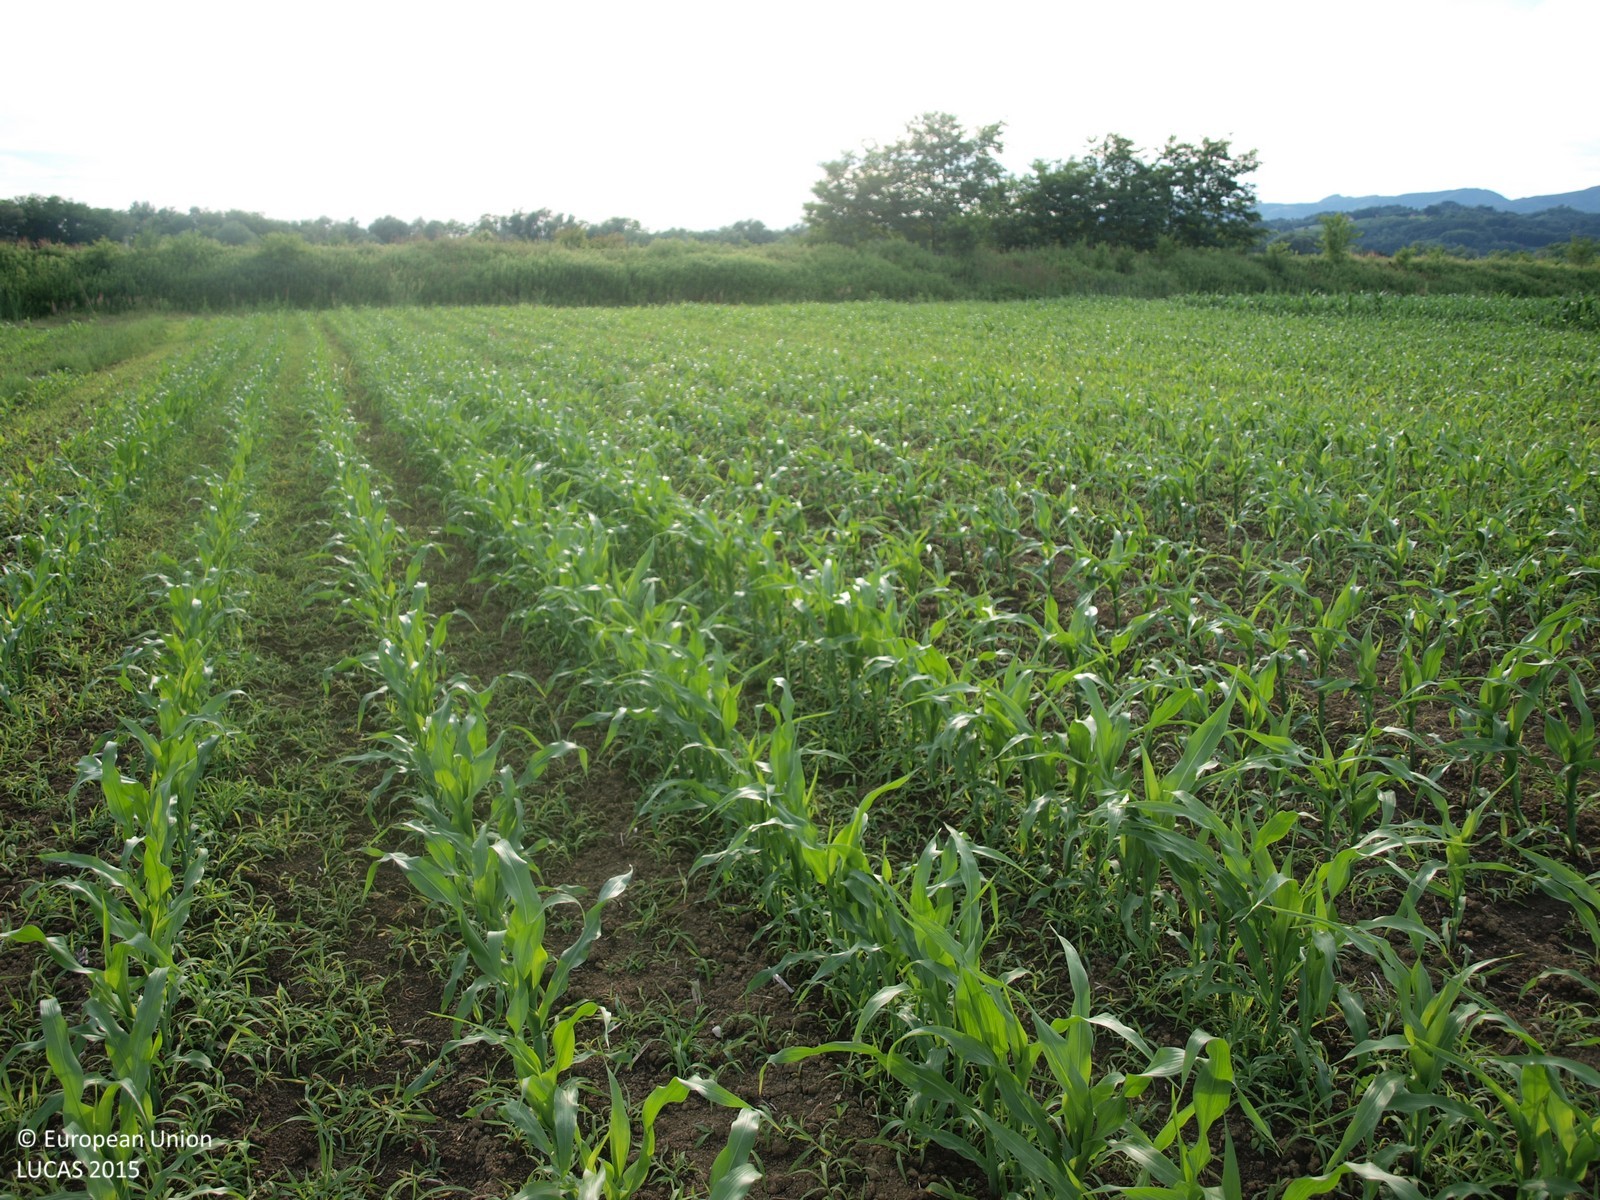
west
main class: Cropland
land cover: Maize
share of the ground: > 75 %
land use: Agriculture (excluding fallow land and kitchen gardens)
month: June
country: HR
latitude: 45.9637
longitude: 15.7142
